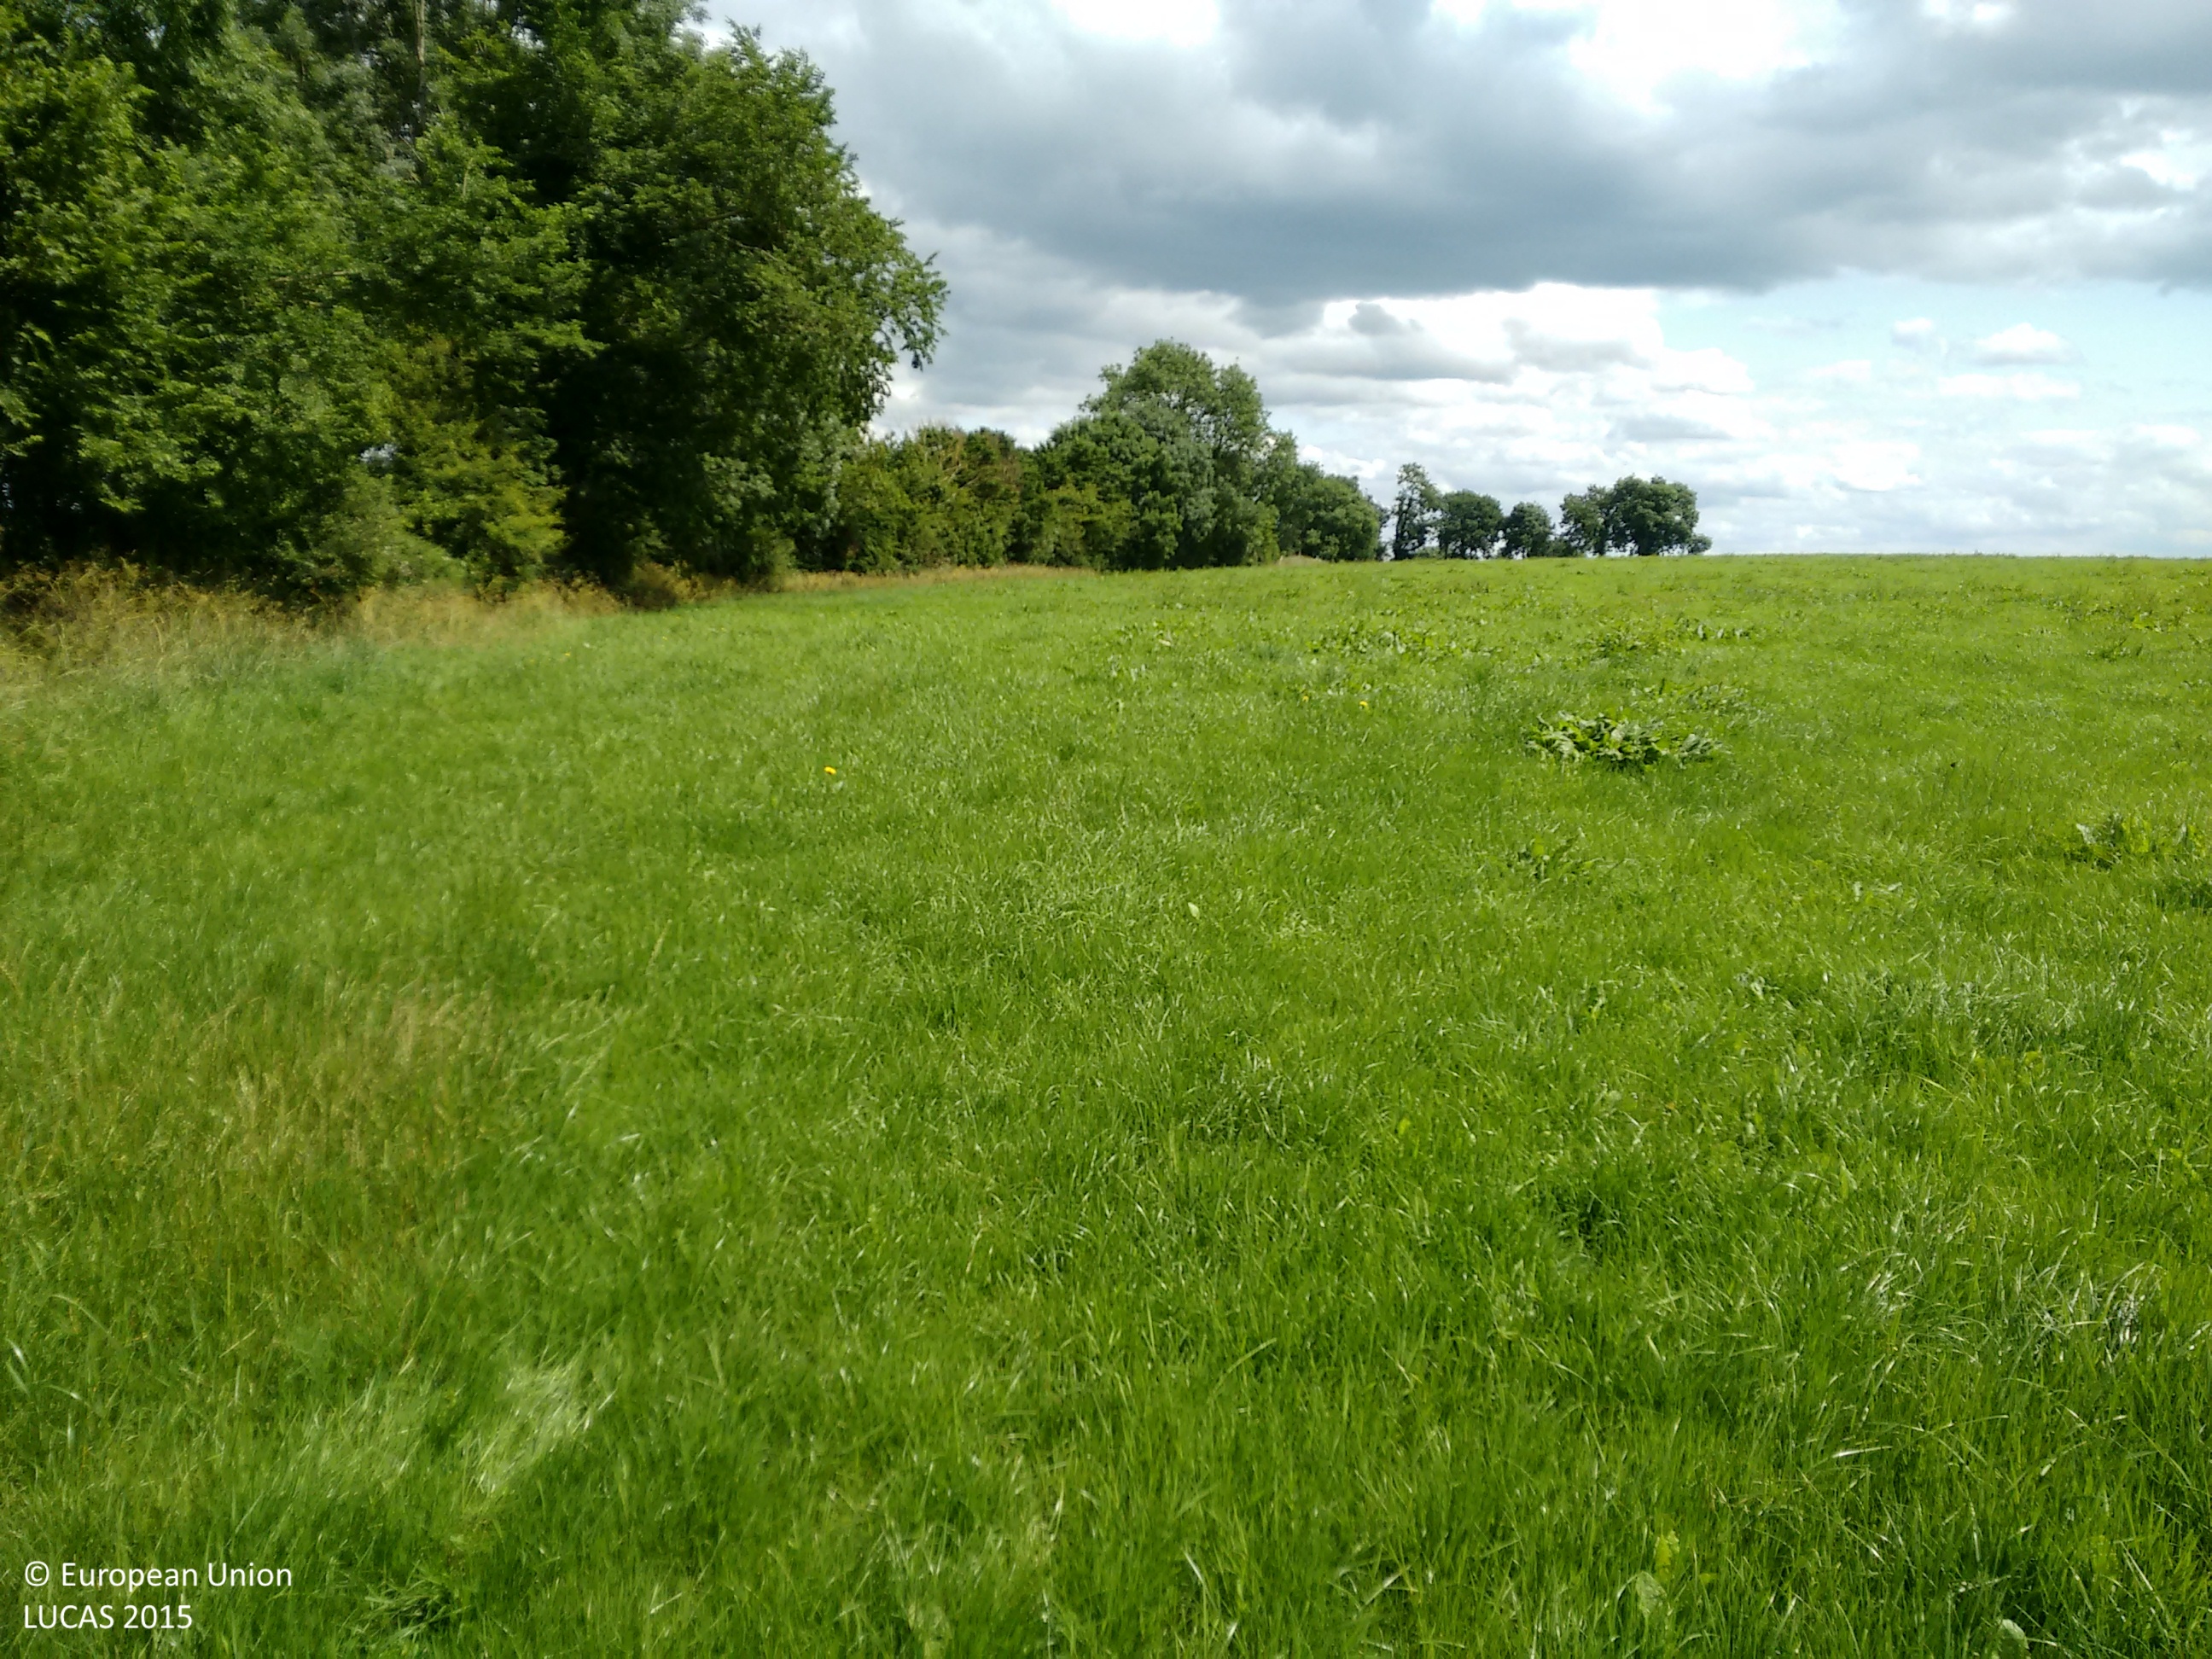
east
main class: Woodland
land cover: Other mixed woodland
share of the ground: > 75 %
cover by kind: herbaceous plants 40 %, coniferous forest trees 30 %, broadleaved forest trees 30 %
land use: Agriculture (excluding fallow land and kitchen gardens)
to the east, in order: Other mixed woodland; Broadleaved woodland; Abandoned hedges; Grass margins; Paved roads, cycling and walking lanes; Grass margins; Abandoned hedges; Grassland without tree/shrub cover
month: July
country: IE
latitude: 52.5608
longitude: -7.5829
